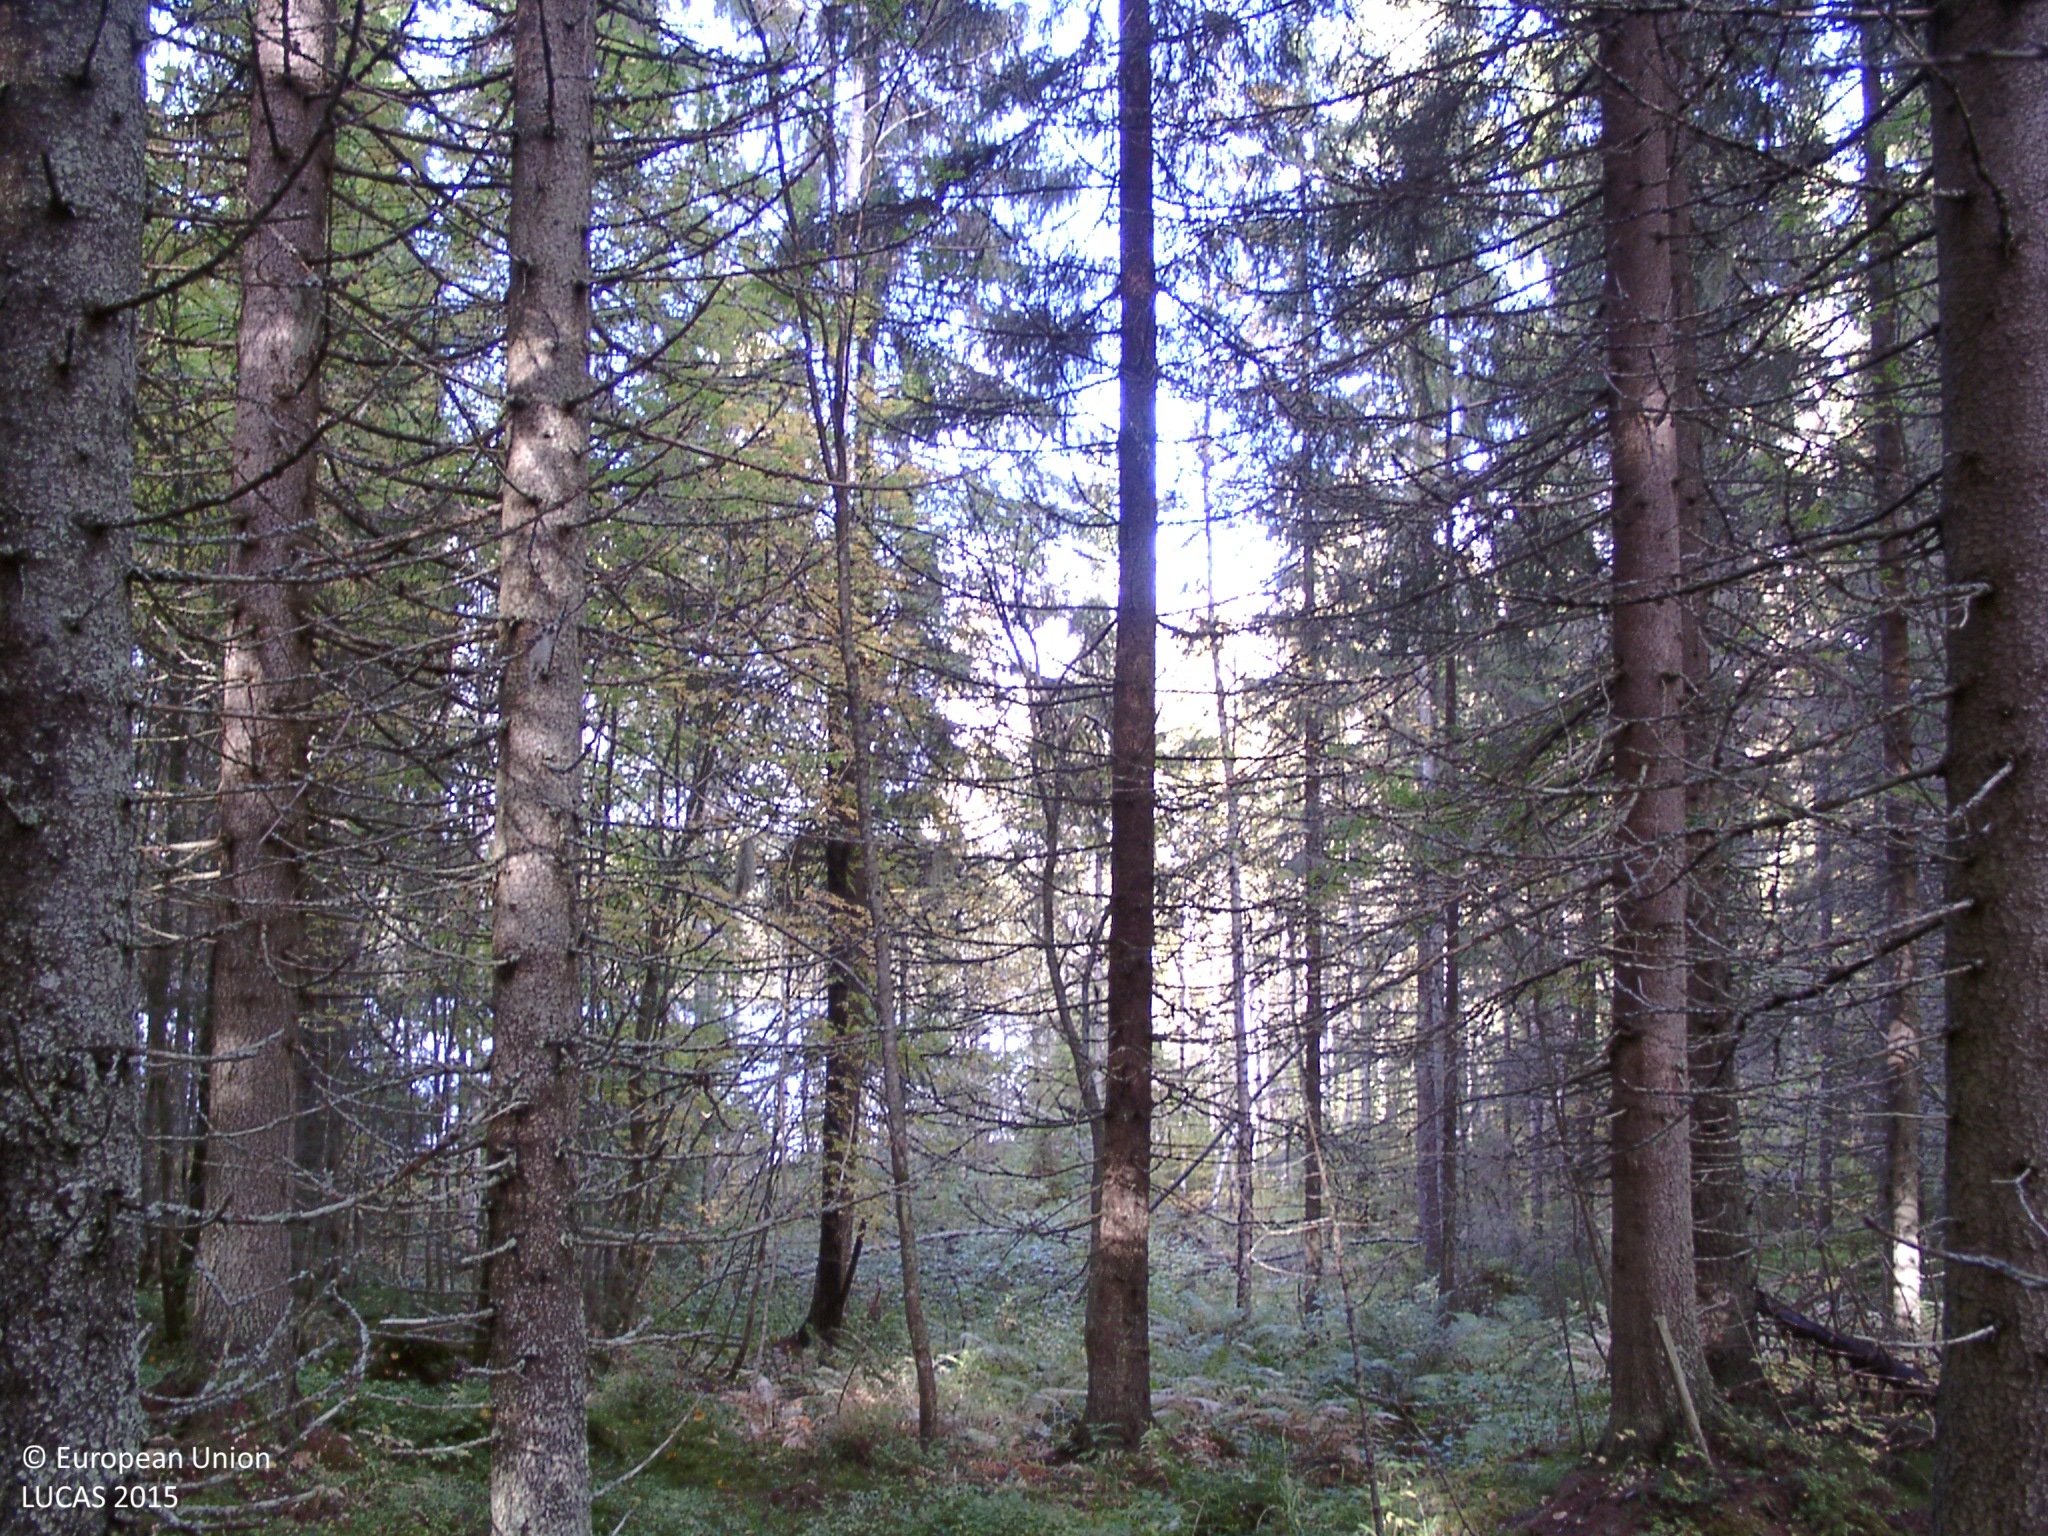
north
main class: Woodland
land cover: Spruce dominated coniferous woodland
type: boreal forest
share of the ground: > 75 %
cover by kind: coniferous forest trees 80 %, broadleaved forest trees 5 %, shrubs 5 %, herbaceous plants 5 %, lichens and mosses 5 %
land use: Forestry
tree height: > 5 m
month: September
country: FI
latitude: 62.5397
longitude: 25.3275
